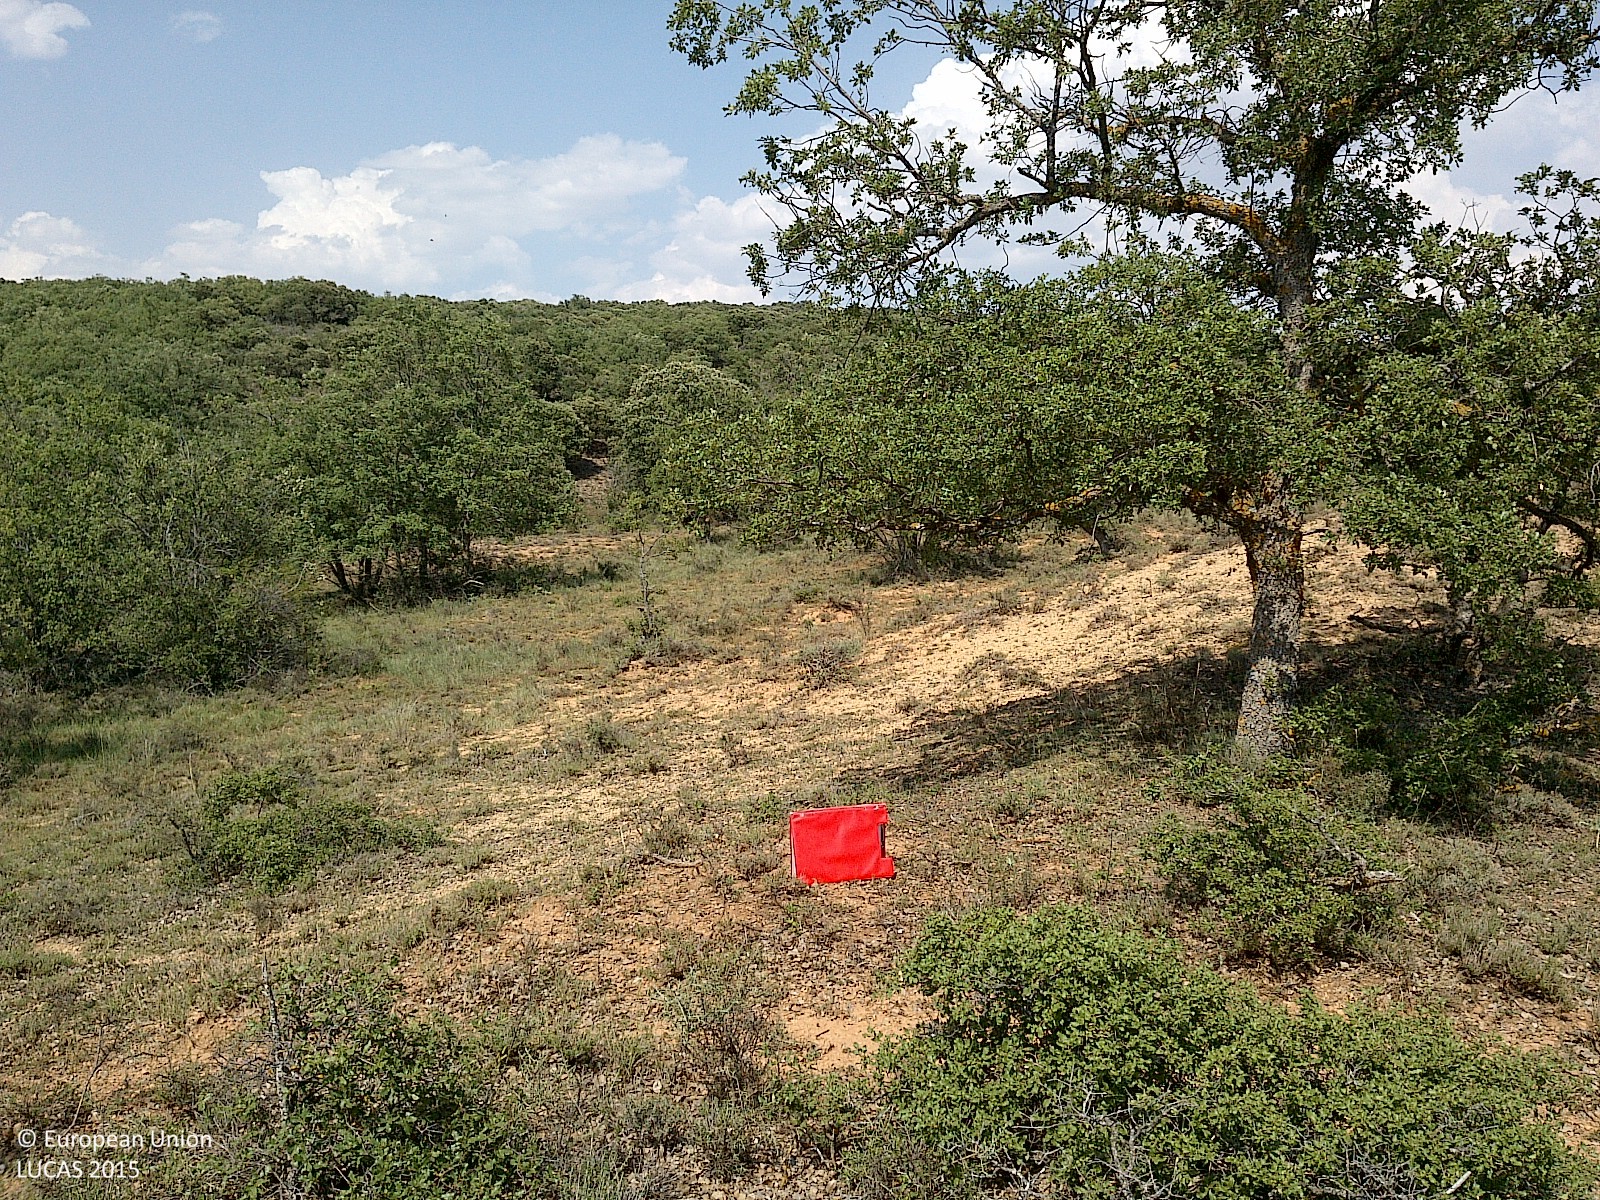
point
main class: Woodland
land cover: Broadleaved woodland
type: broadleaved evergreen forest
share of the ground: 25 - 50 %
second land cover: Grassland without tree/shrub cover
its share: 50 - 75 %
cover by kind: herbaceous plants 50 %, broadleaved forest trees 30 %, shrubs 10 %, unconsolidated bare surface 10 %
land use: Forestry
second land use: Agriculture (excluding fallow land and kitchen gardens)
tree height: < 5 m
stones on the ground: < 10 %
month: June
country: ES
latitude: 41.5426
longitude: -2.2483
